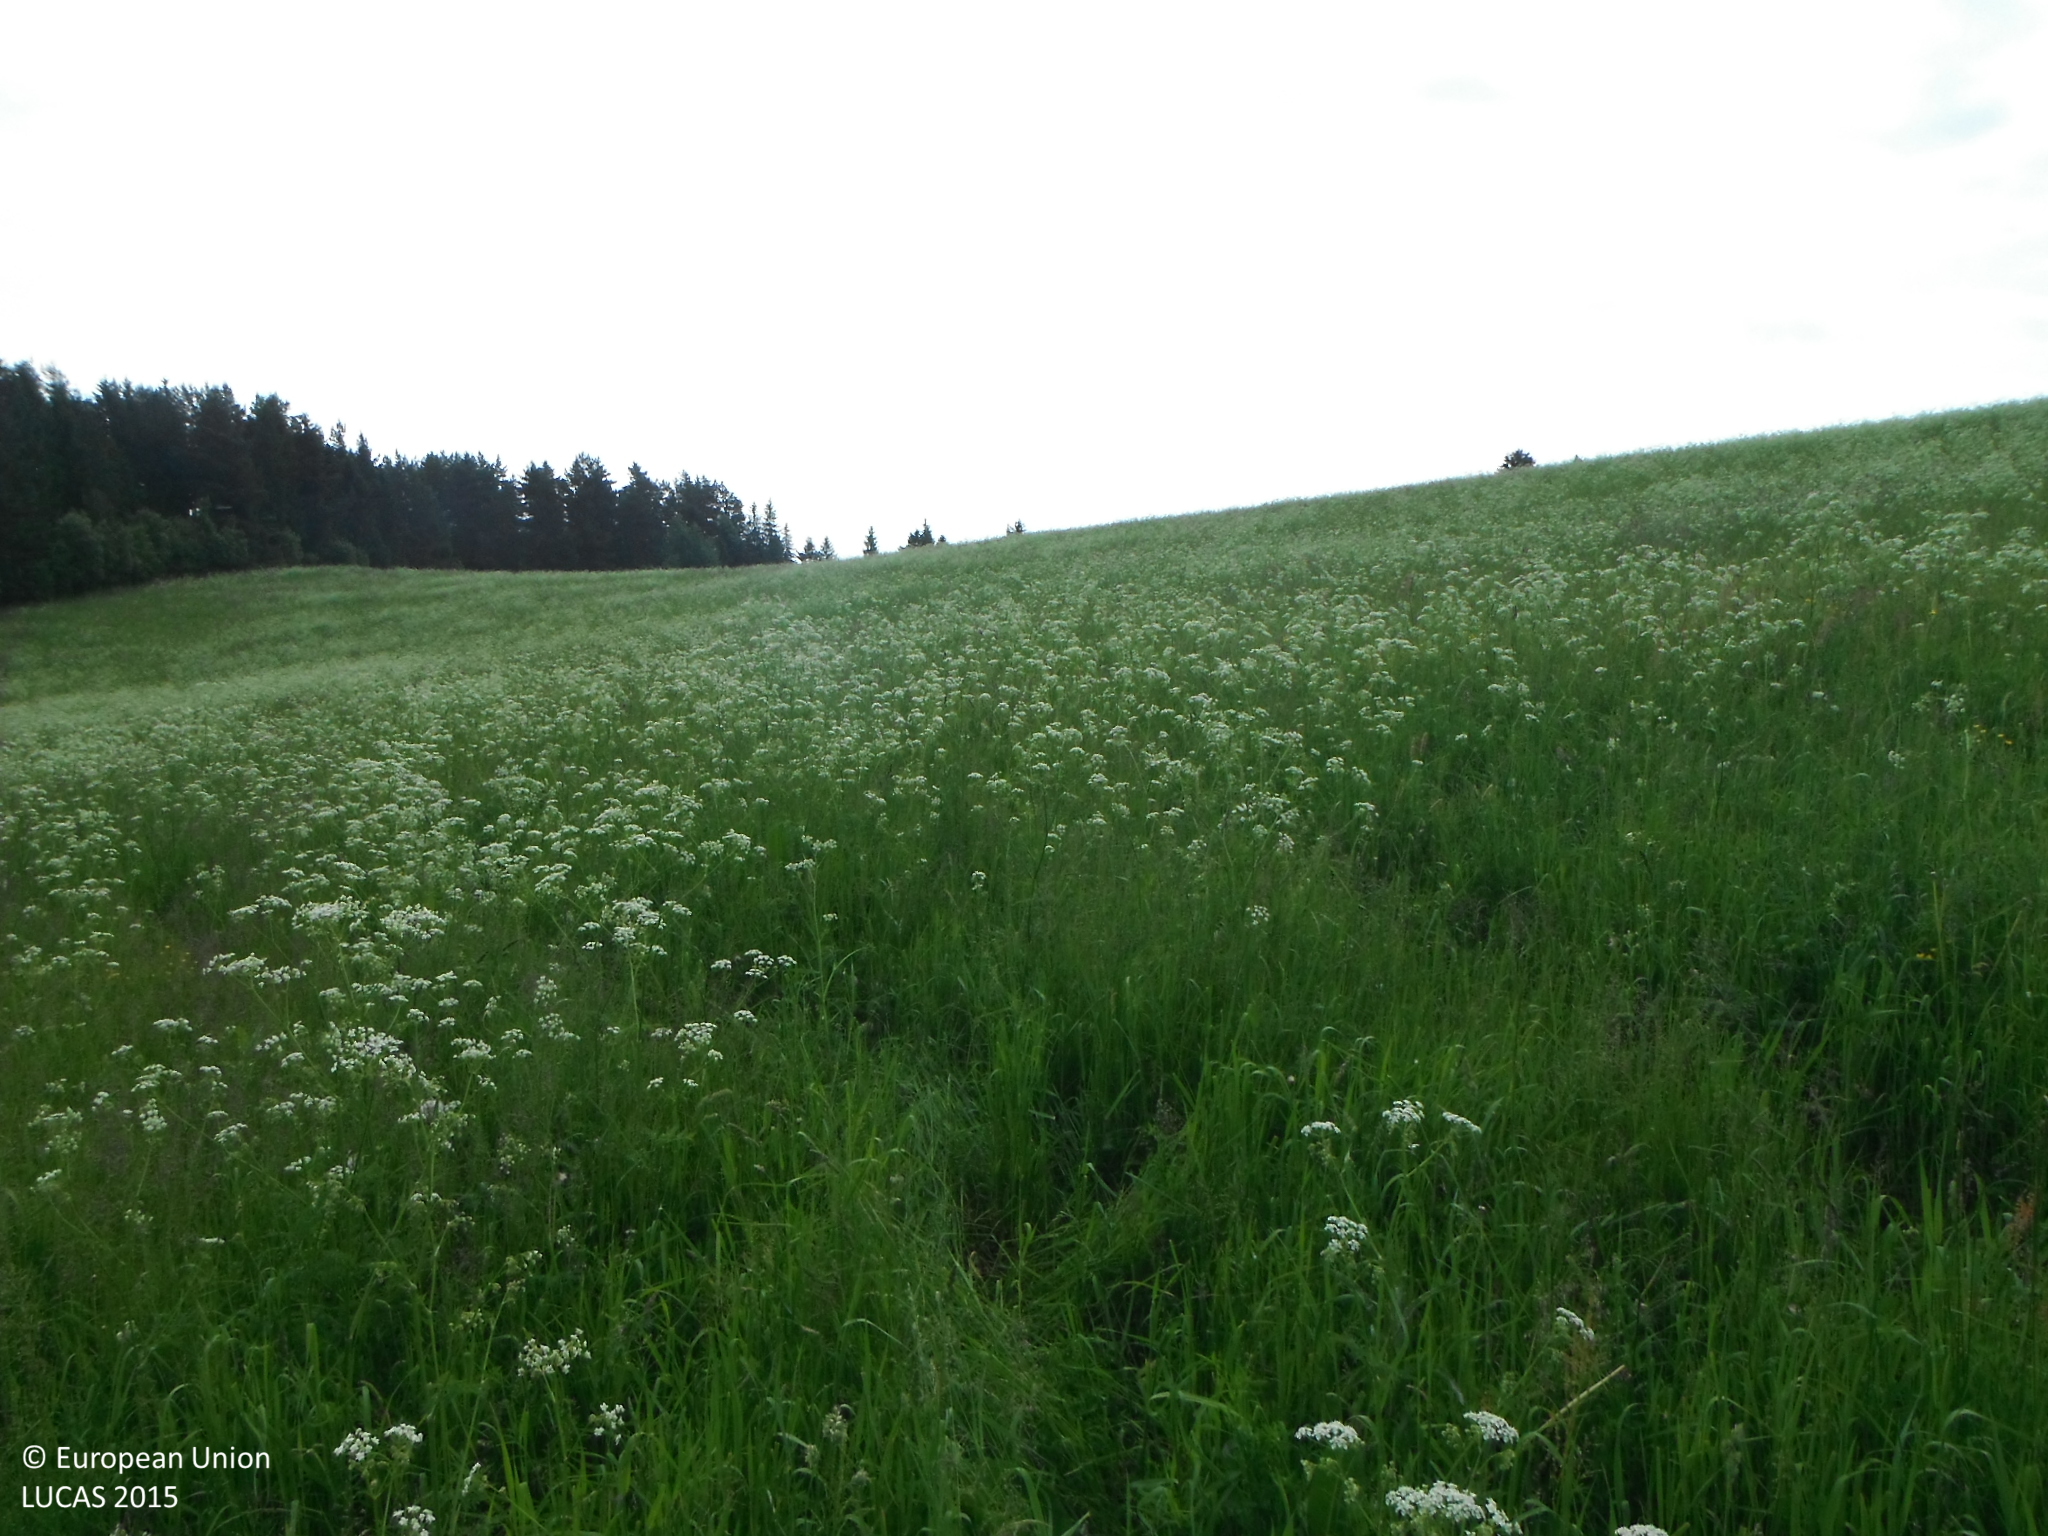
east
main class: Grassland
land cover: Grassland without tree/shrub cover
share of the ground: > 75 %
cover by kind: herbaceous plants 100 %
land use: Agriculture (excluding fallow land and kitchen gardens)
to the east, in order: Grassland without tree/shrub cover
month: June
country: SK
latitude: 49.3827
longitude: 20.3804
